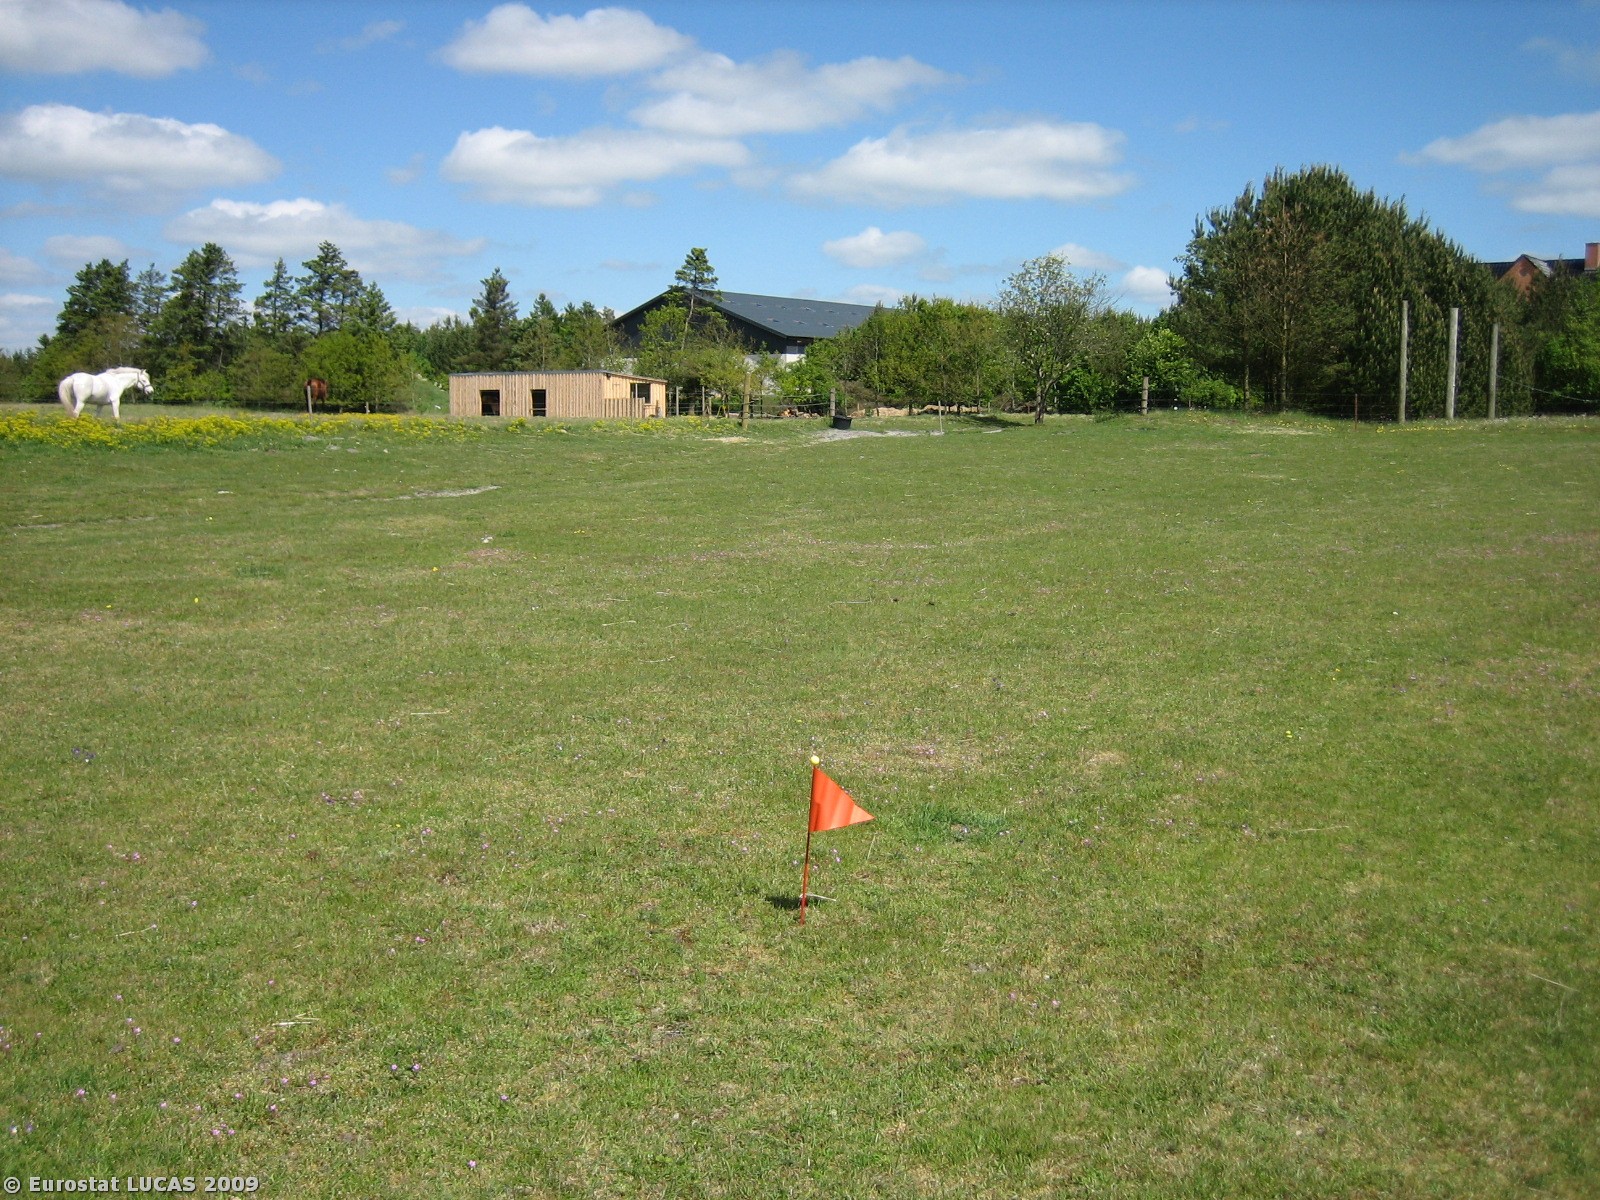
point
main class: Grassland
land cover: Grassland without tree/shrub cover
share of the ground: > 75 %
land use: Residential
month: May
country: DK
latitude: 56.0399
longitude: 8.9899
